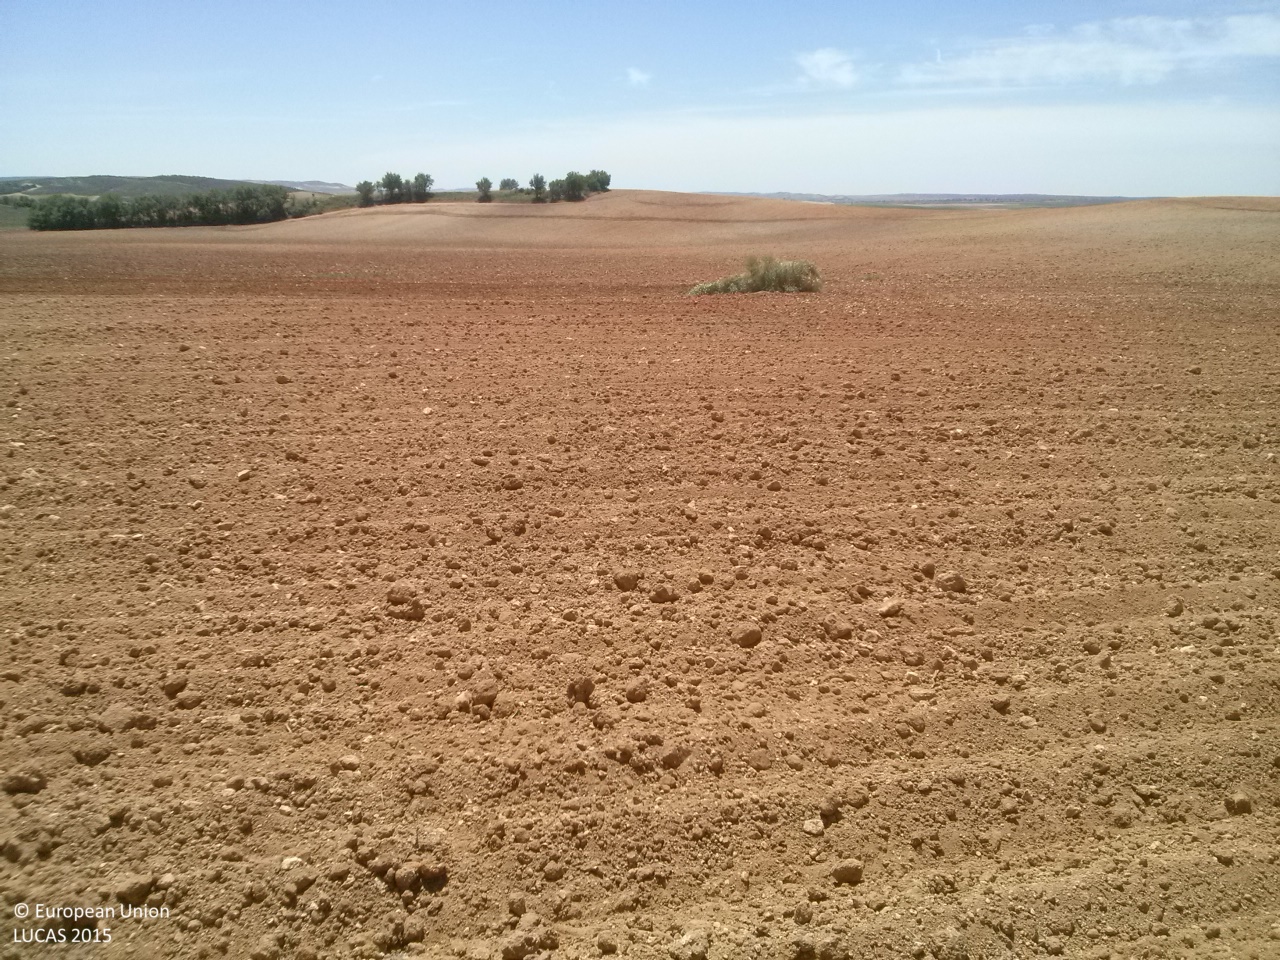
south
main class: Cropland
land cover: Sunflower
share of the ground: < 10 %
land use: Agriculture (excluding fallow land and kitchen gardens)
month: May
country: ES
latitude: 39.9806
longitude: -2.7494
